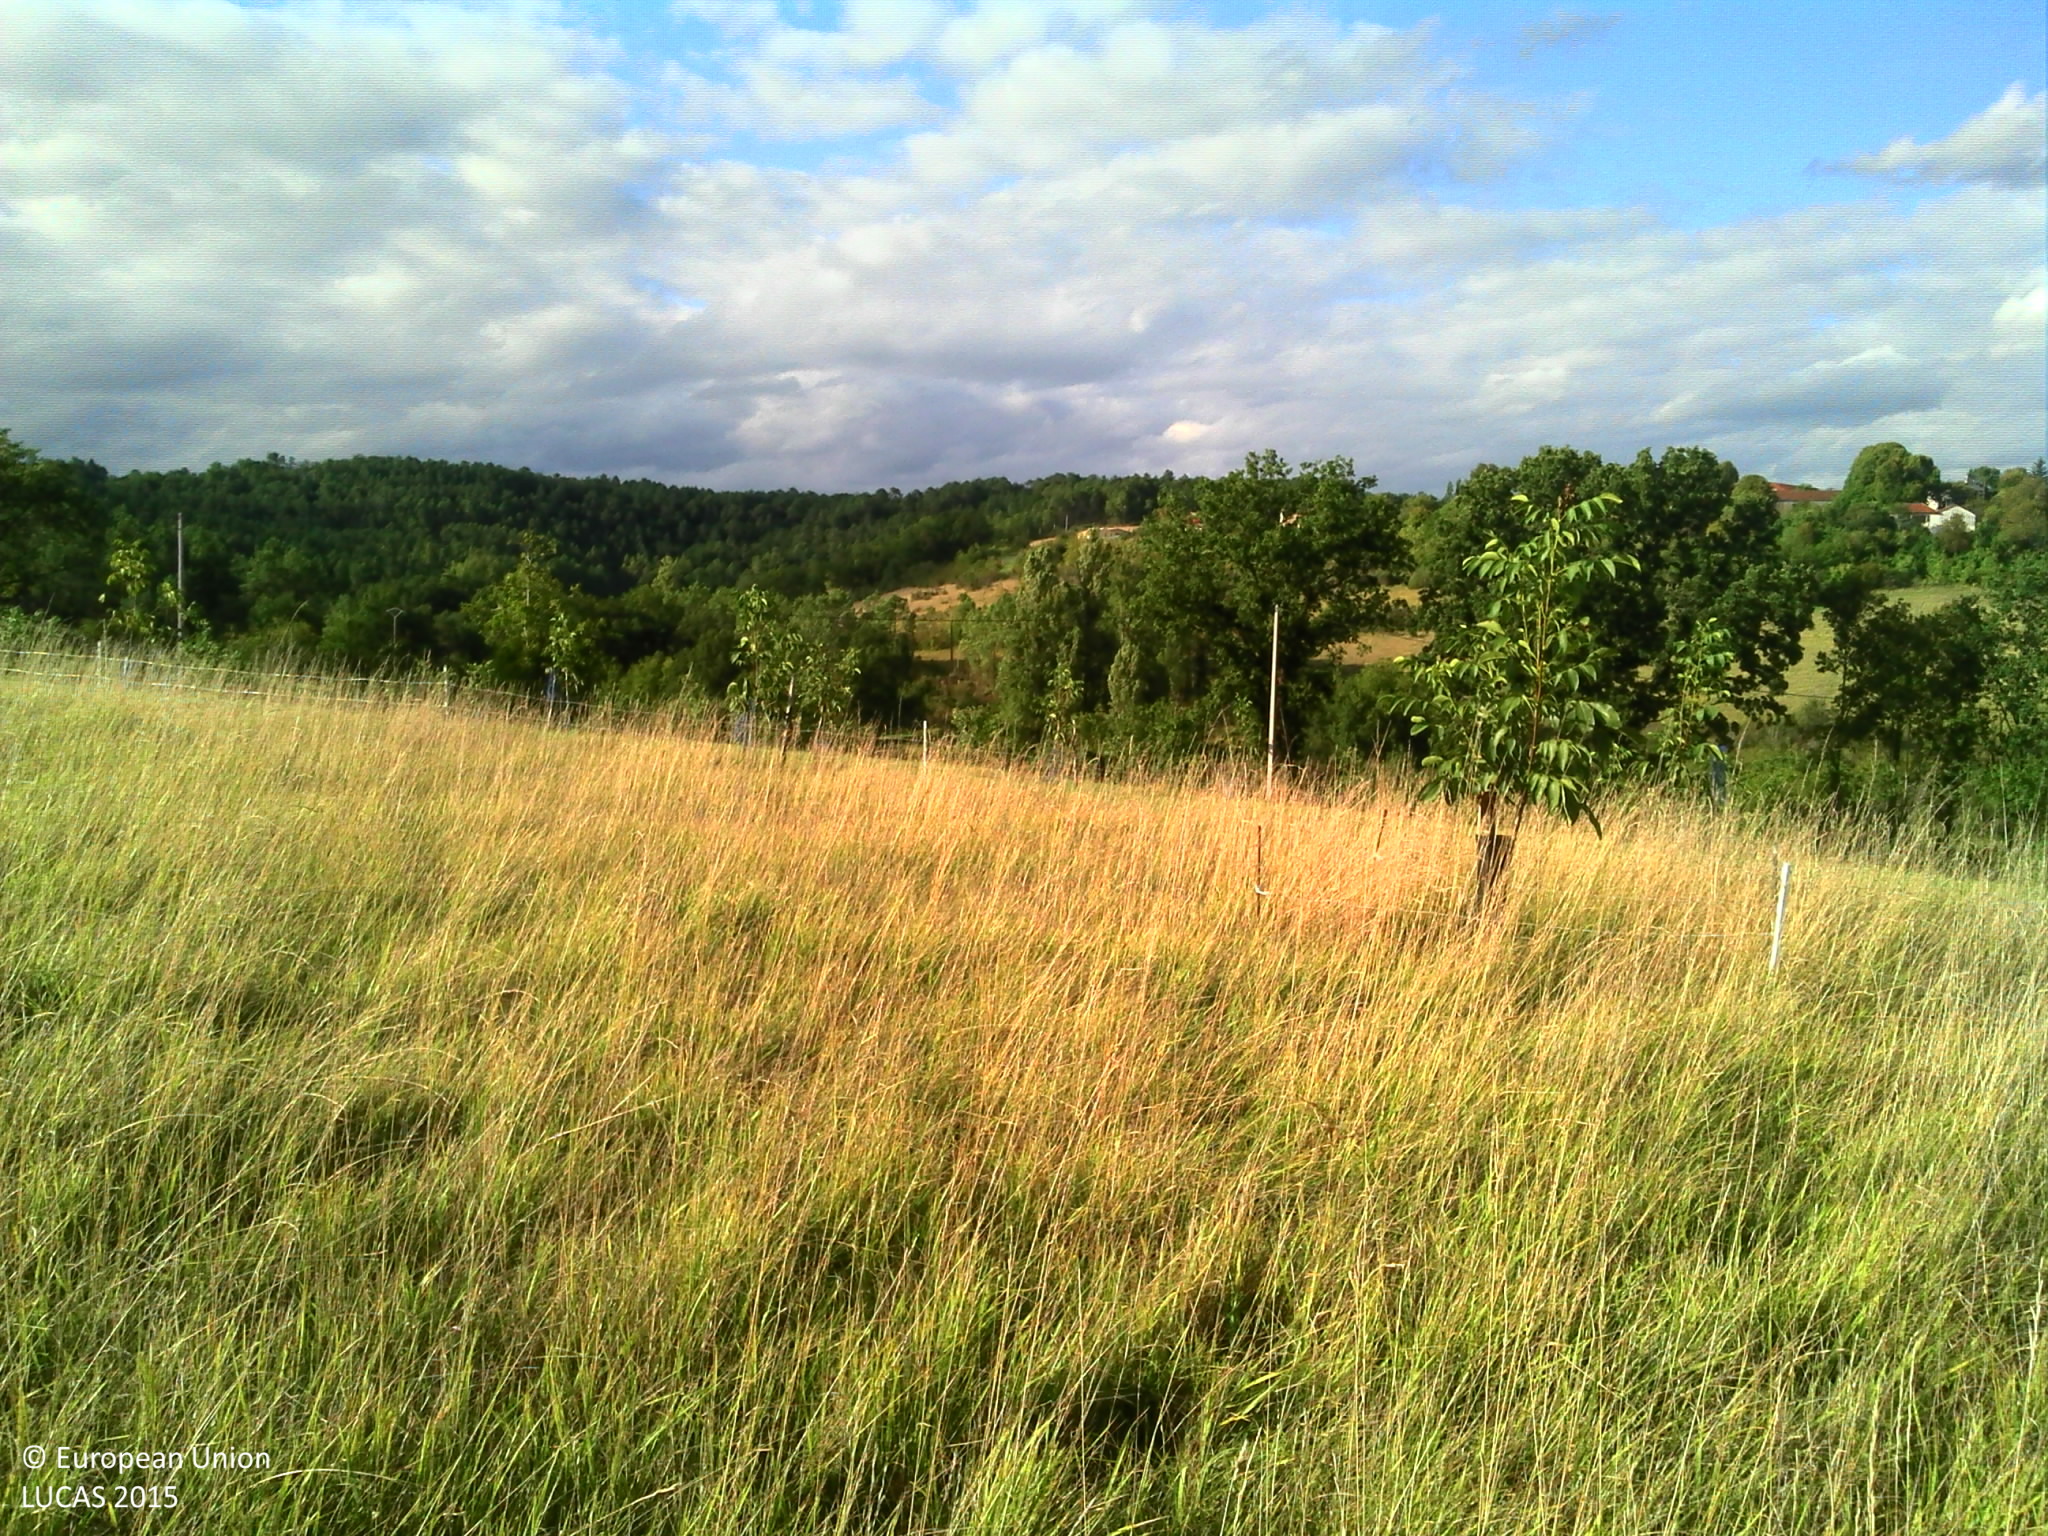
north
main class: Grassland
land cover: Grassland without tree/shrub cover
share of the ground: > 75 %
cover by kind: herbaceous plants 90 %, lichens and mosses 10 %
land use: Agriculture (excluding fallow land and kitchen gardens)
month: August
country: FR
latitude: 45.1869
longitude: 0.5324
